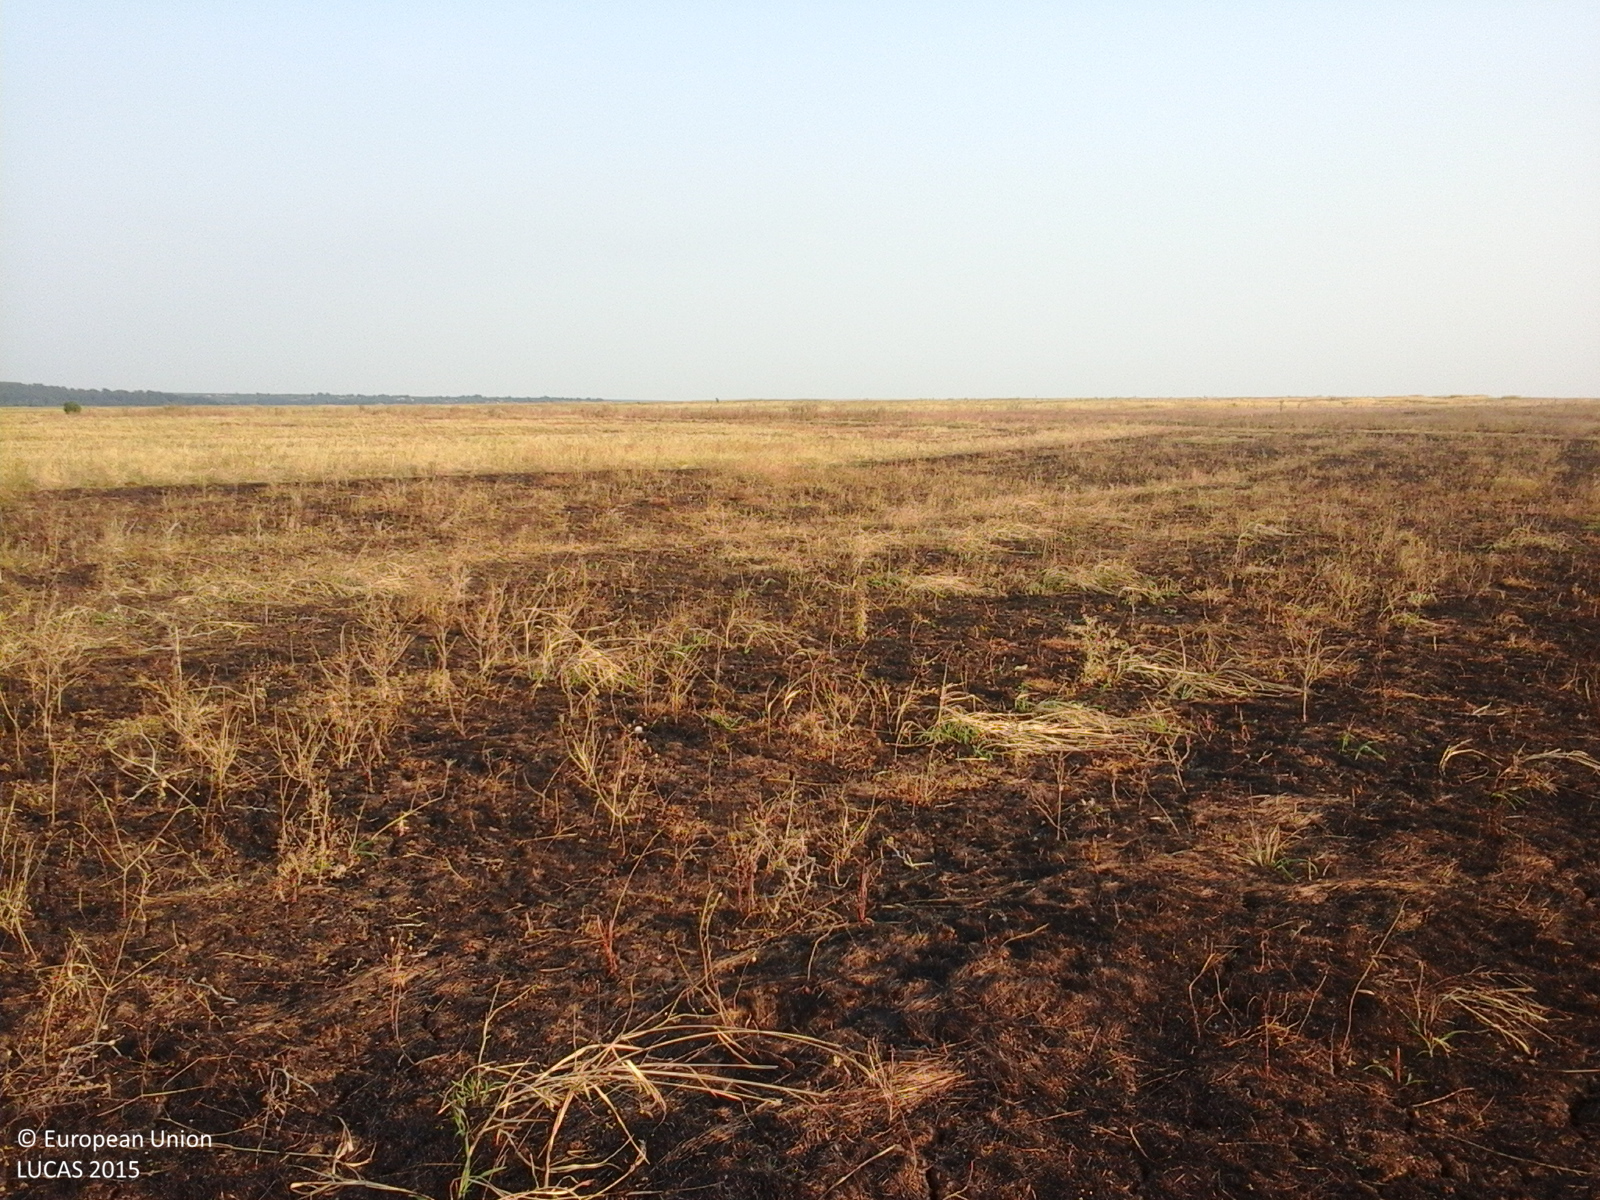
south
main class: Grassland
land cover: Spontaneously vegetated surfaces
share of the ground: > 75 %
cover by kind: herbaceous plants 100 %
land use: Fallow land
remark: Burnt area
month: August
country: RO
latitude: 44.2553
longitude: 23.5920
